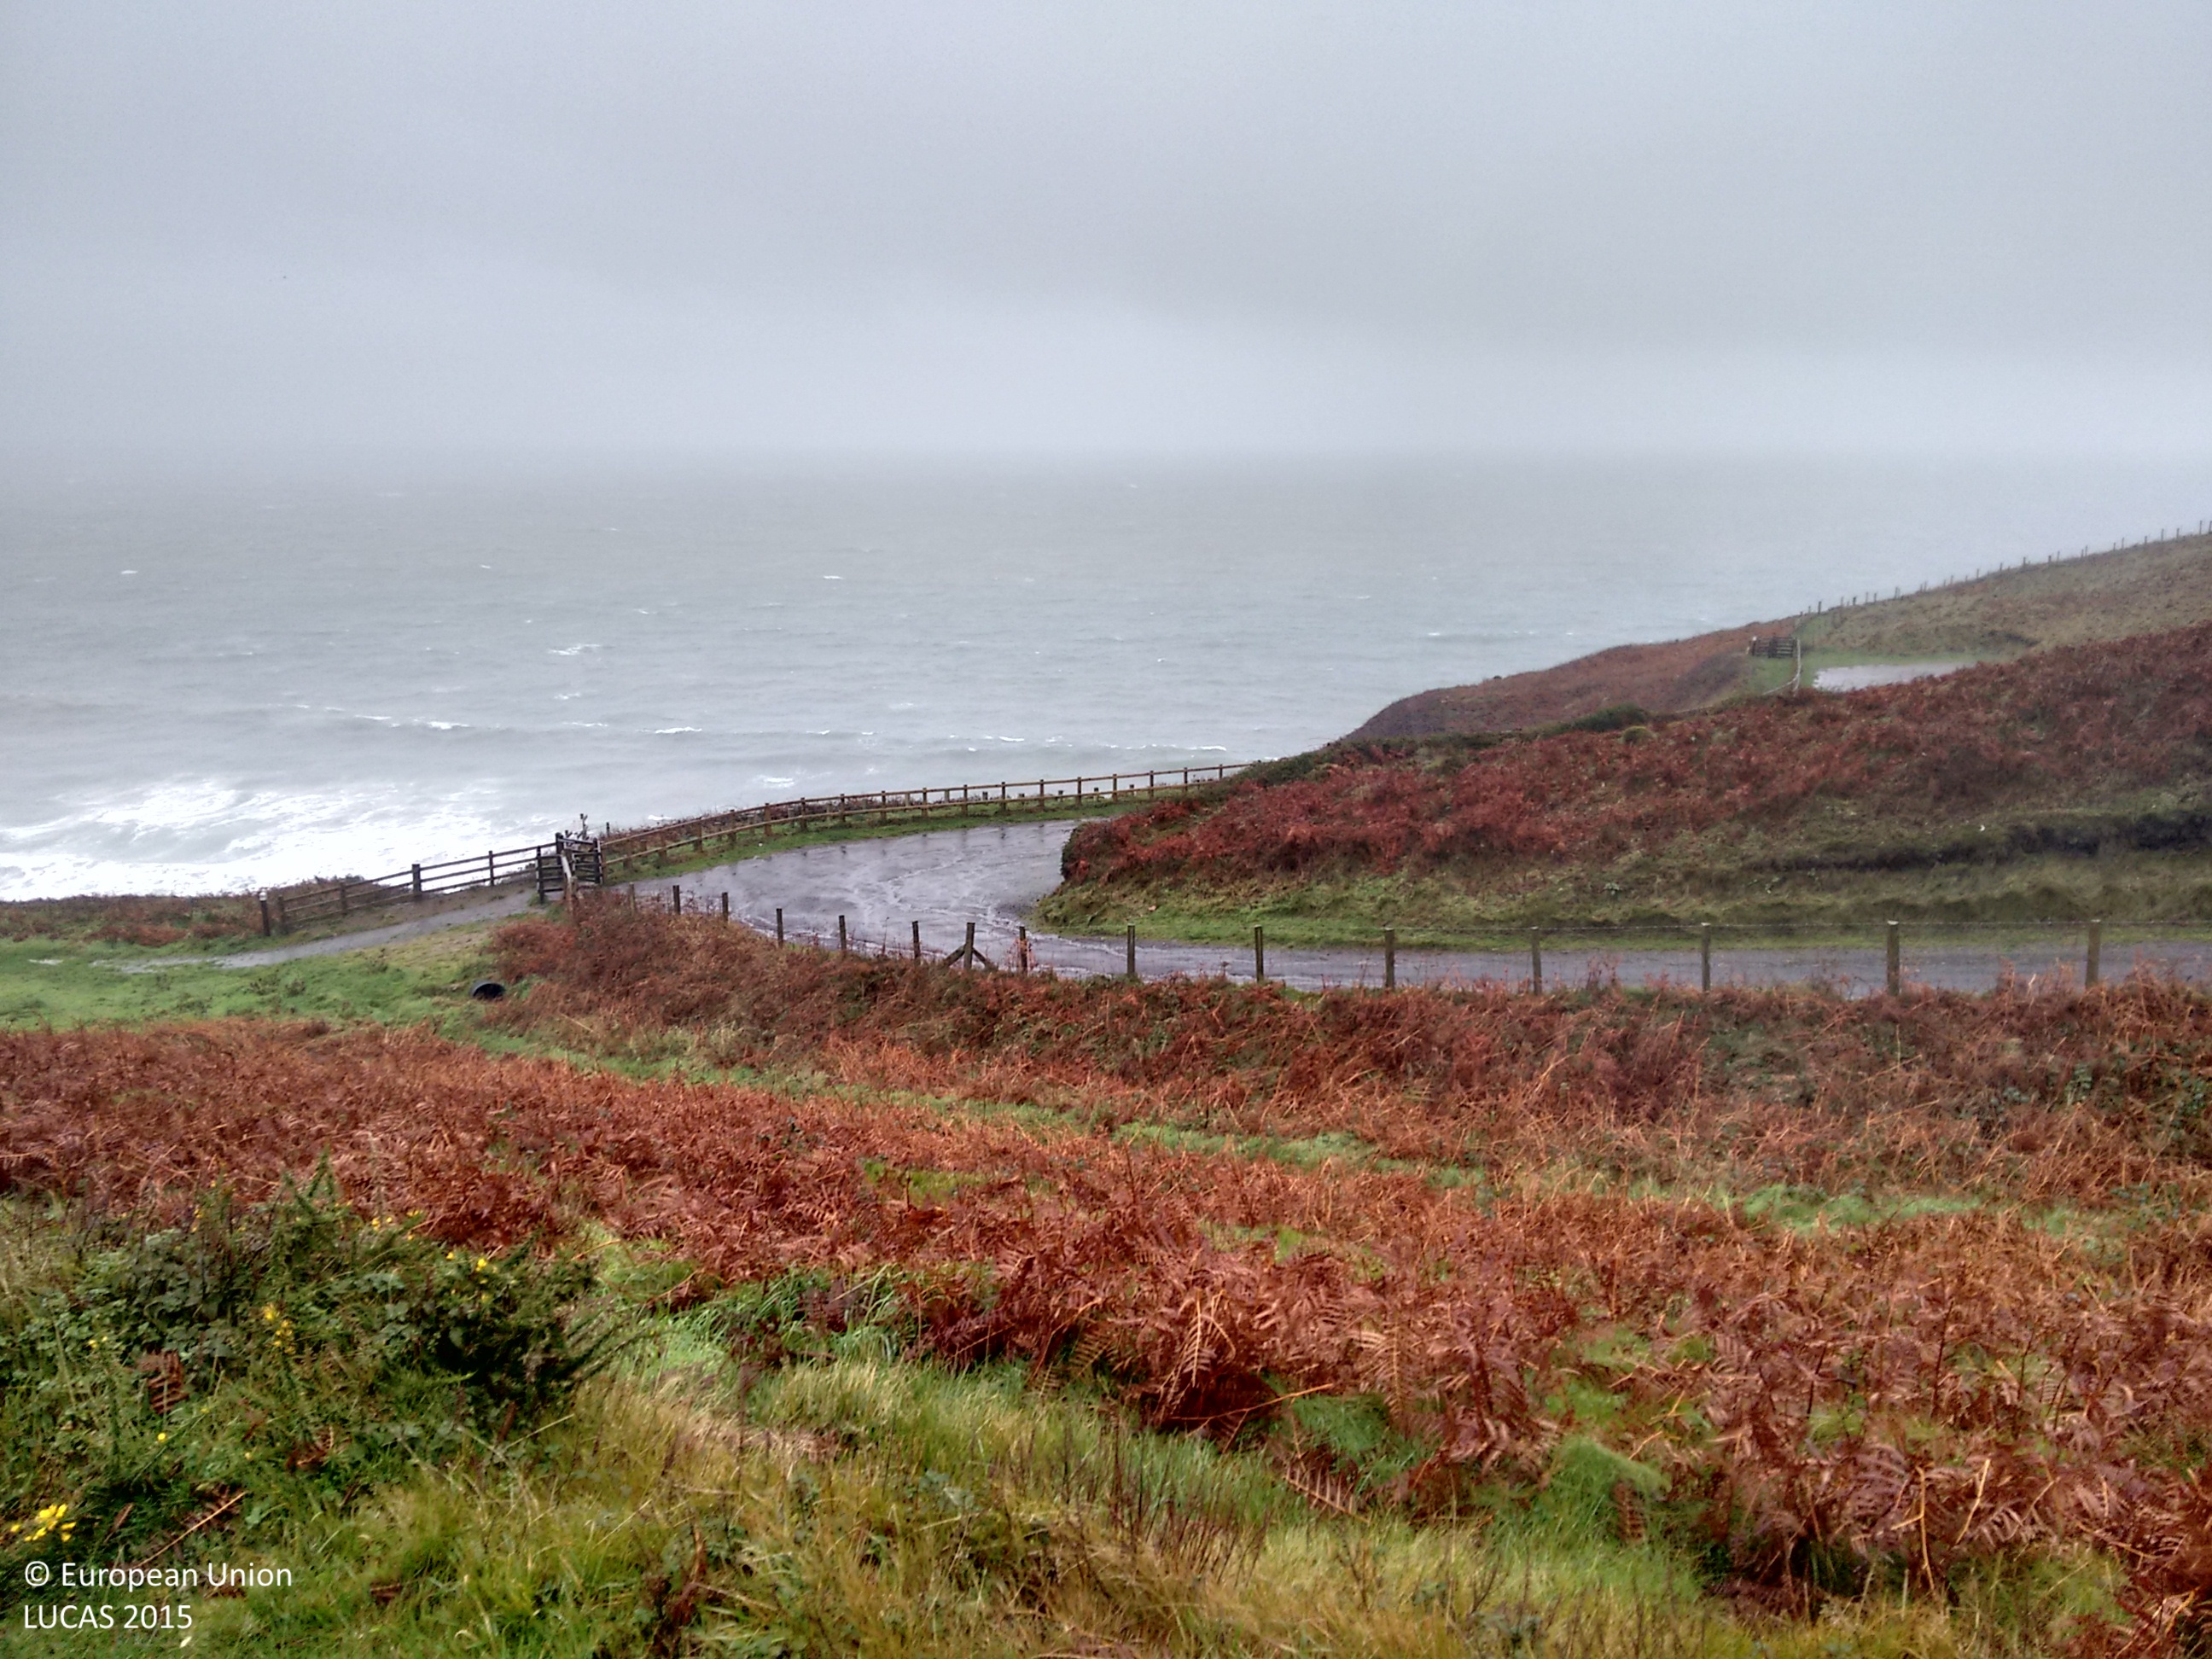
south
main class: Shrubland
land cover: Shrubland without tree cover
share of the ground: > 75 %
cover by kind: shrubs 80 %, herbaceous plants 20 %
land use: Agriculture (excluding fallow land and kitchen gardens)
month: November
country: GB
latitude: 52.7962
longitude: -4.5061
